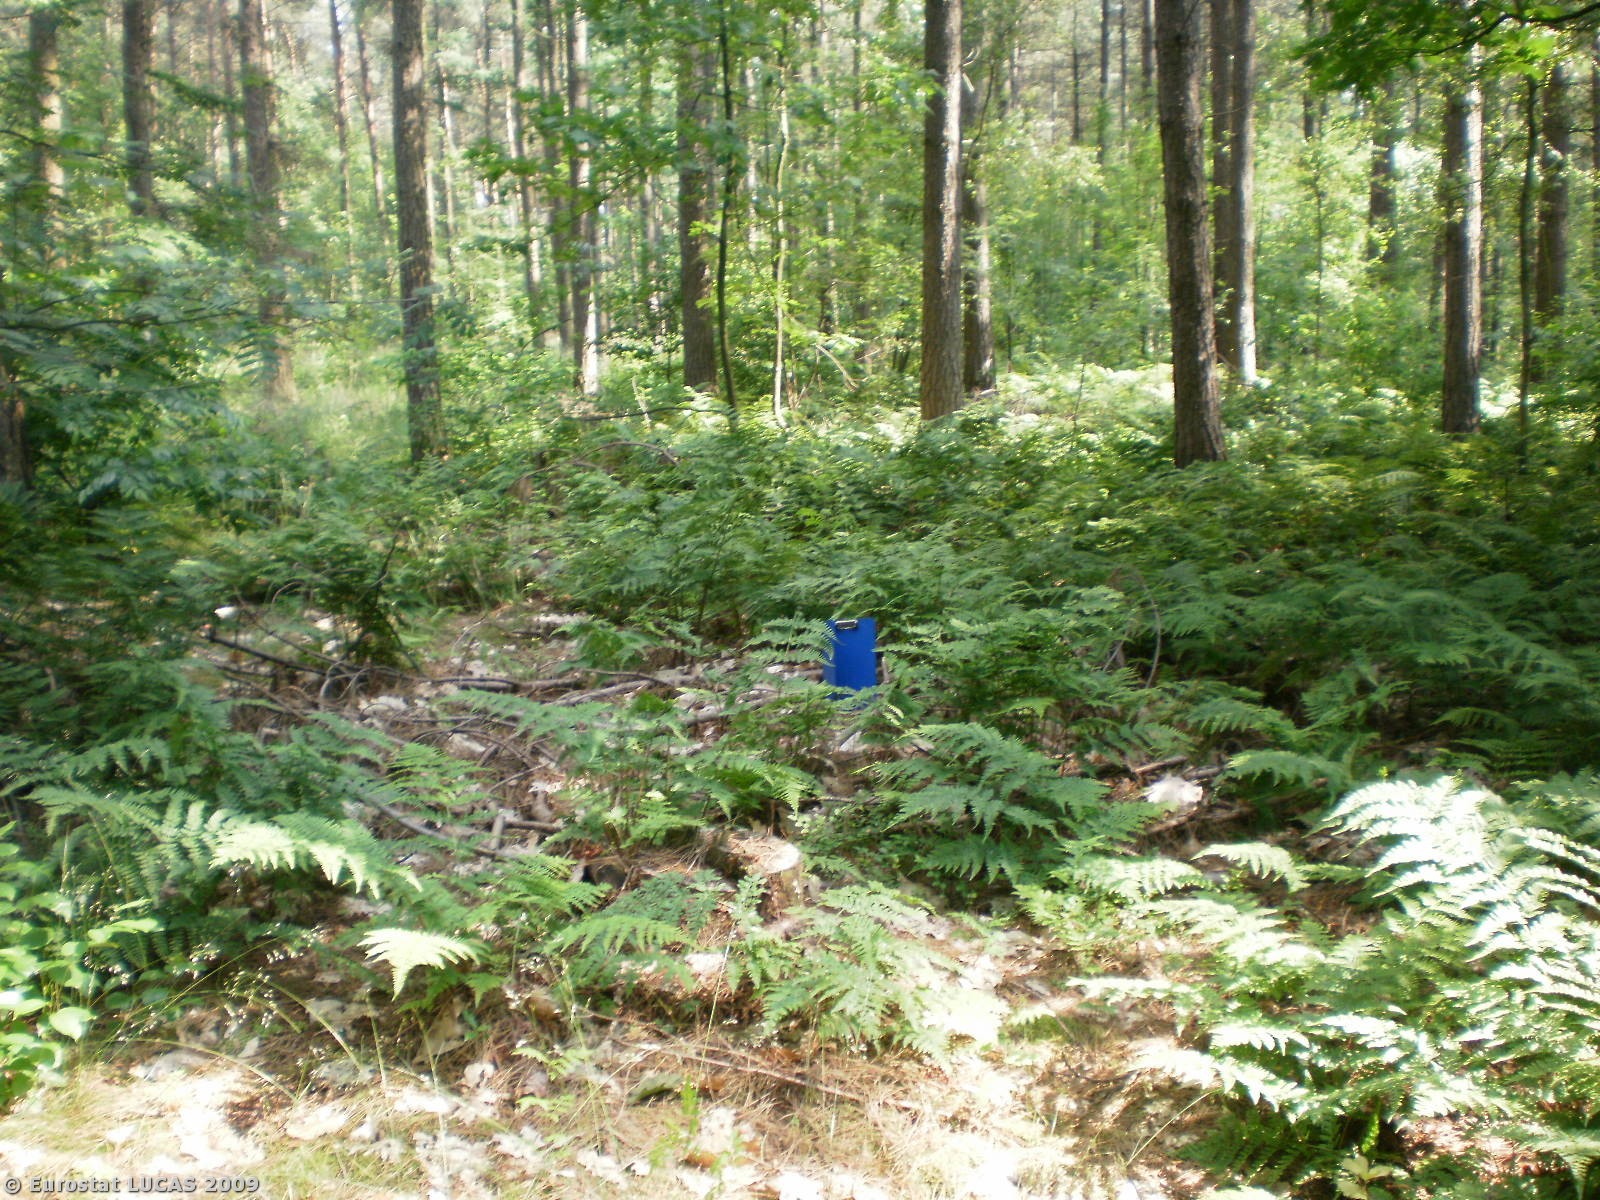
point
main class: Woodland
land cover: Mixed woodland
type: hemiboreal forest and nemoral coniferous forest and mixed broadleaved-coniferous forest
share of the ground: > 75 %
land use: Nature reserves
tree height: > 5 m
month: June
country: BE
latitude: 51.0299
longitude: 5.4495
